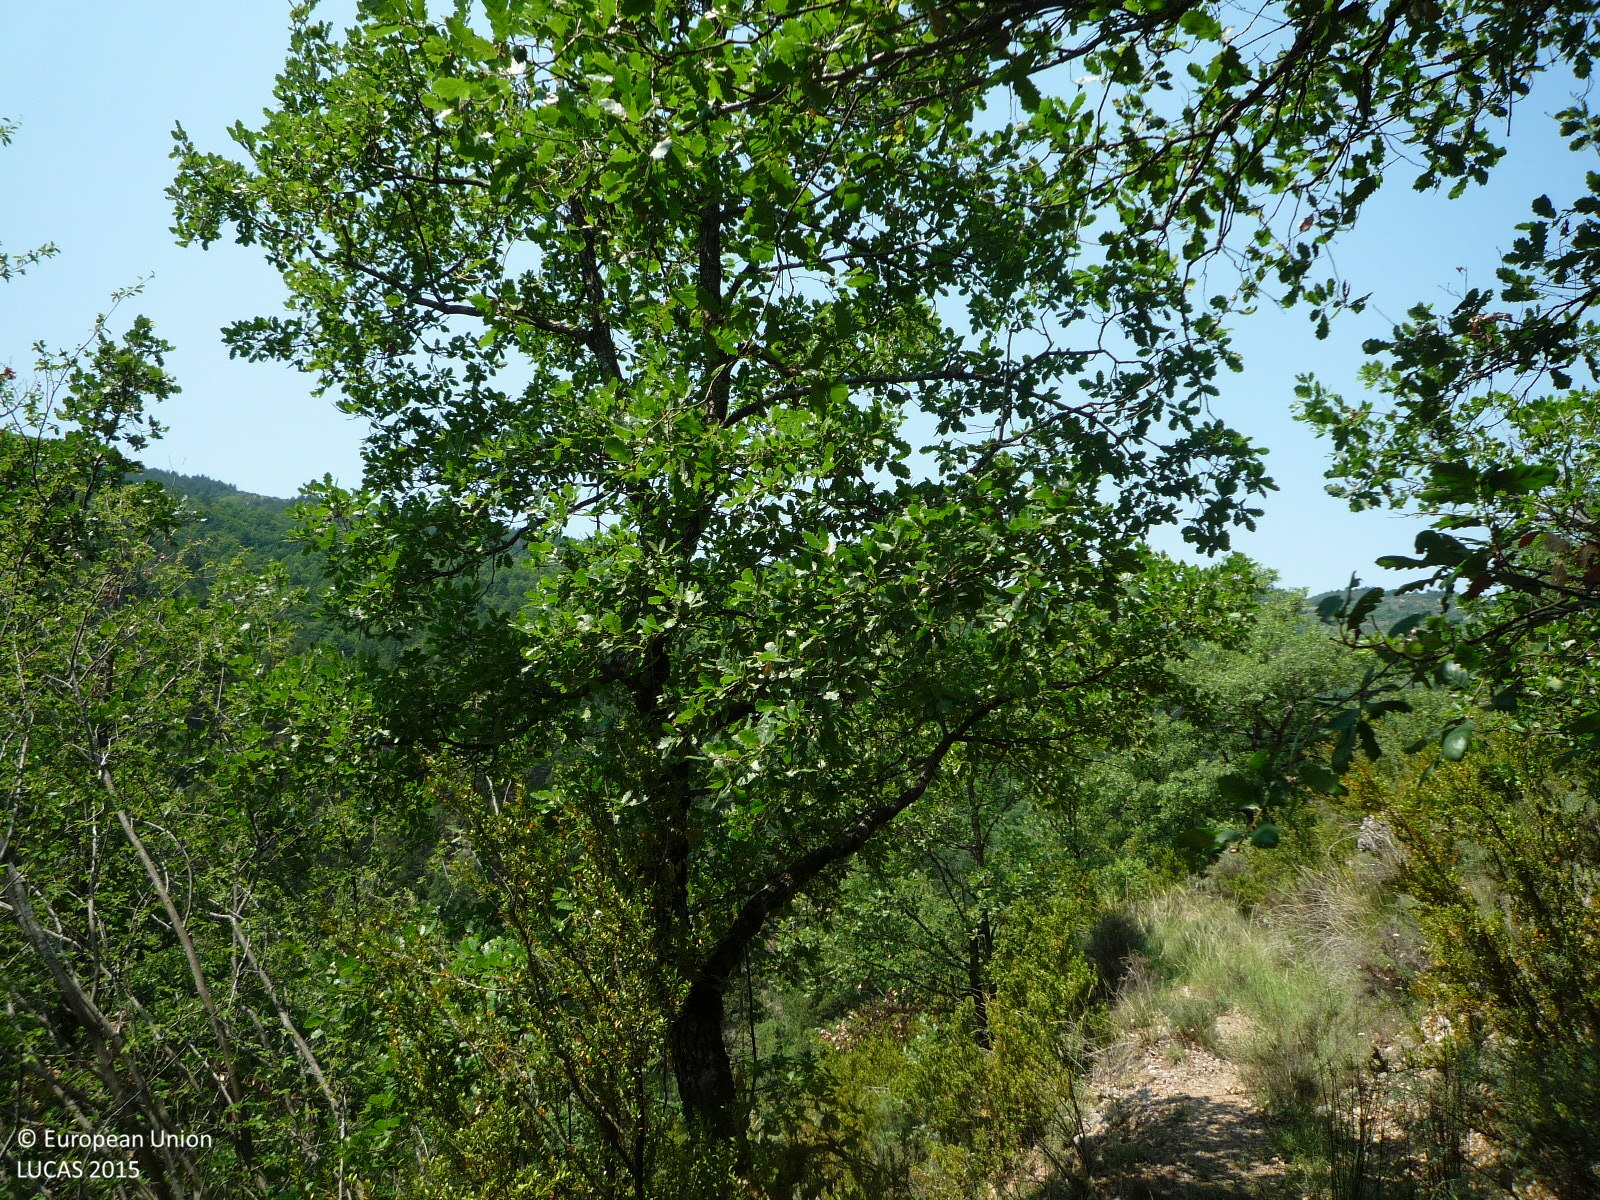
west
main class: Woodland
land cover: Broadleaved woodland
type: acidophilous oak and oak-birch forest
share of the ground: > 75 %
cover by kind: broadleaved forest trees 60 %, shrubs 20 %, herbaceous plants 10 %, lichens and mosses 10 %
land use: Semi-natural and natural areas not in use
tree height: > 5 m
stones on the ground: > 50 %
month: June
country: ES
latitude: 42.3229
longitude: 1.6016
